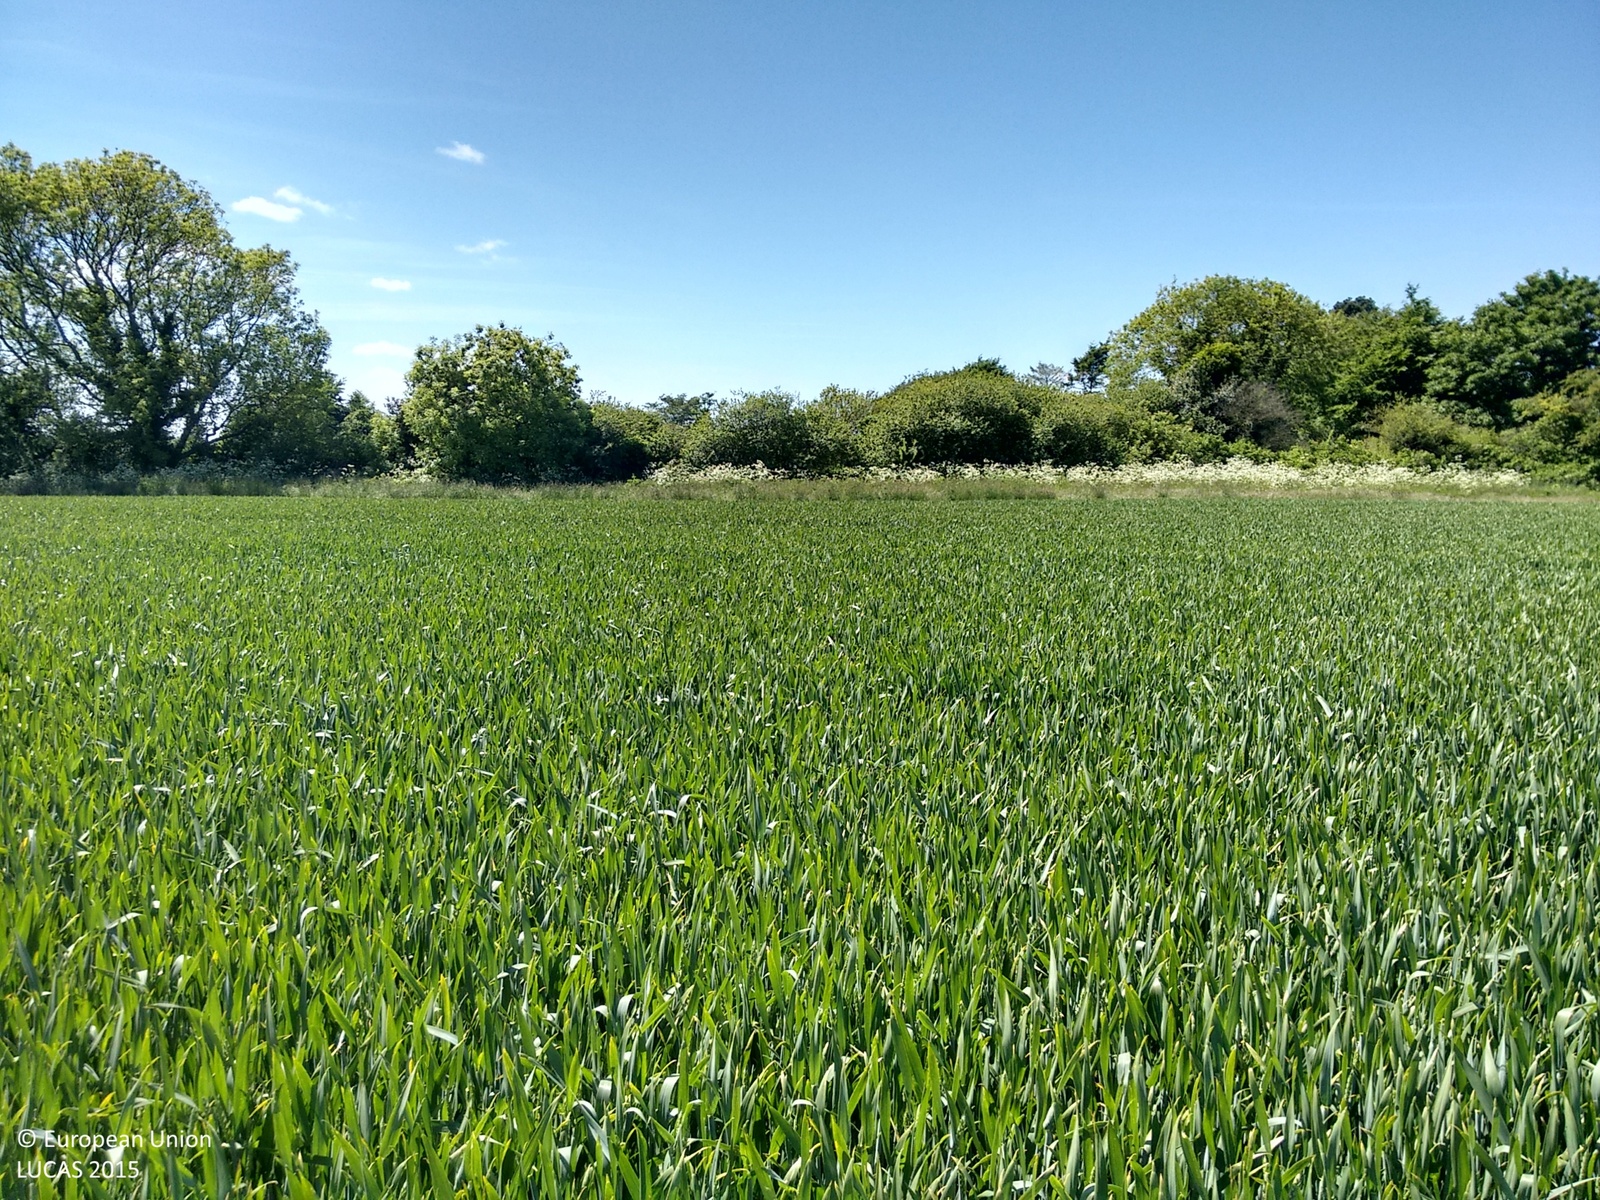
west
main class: Cropland
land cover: Common wheat
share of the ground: > 75 %
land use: Agriculture (excluding fallow land and kitchen gardens)
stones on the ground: < 10 %
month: June
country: GB
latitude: 54.0747
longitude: -0.8457
